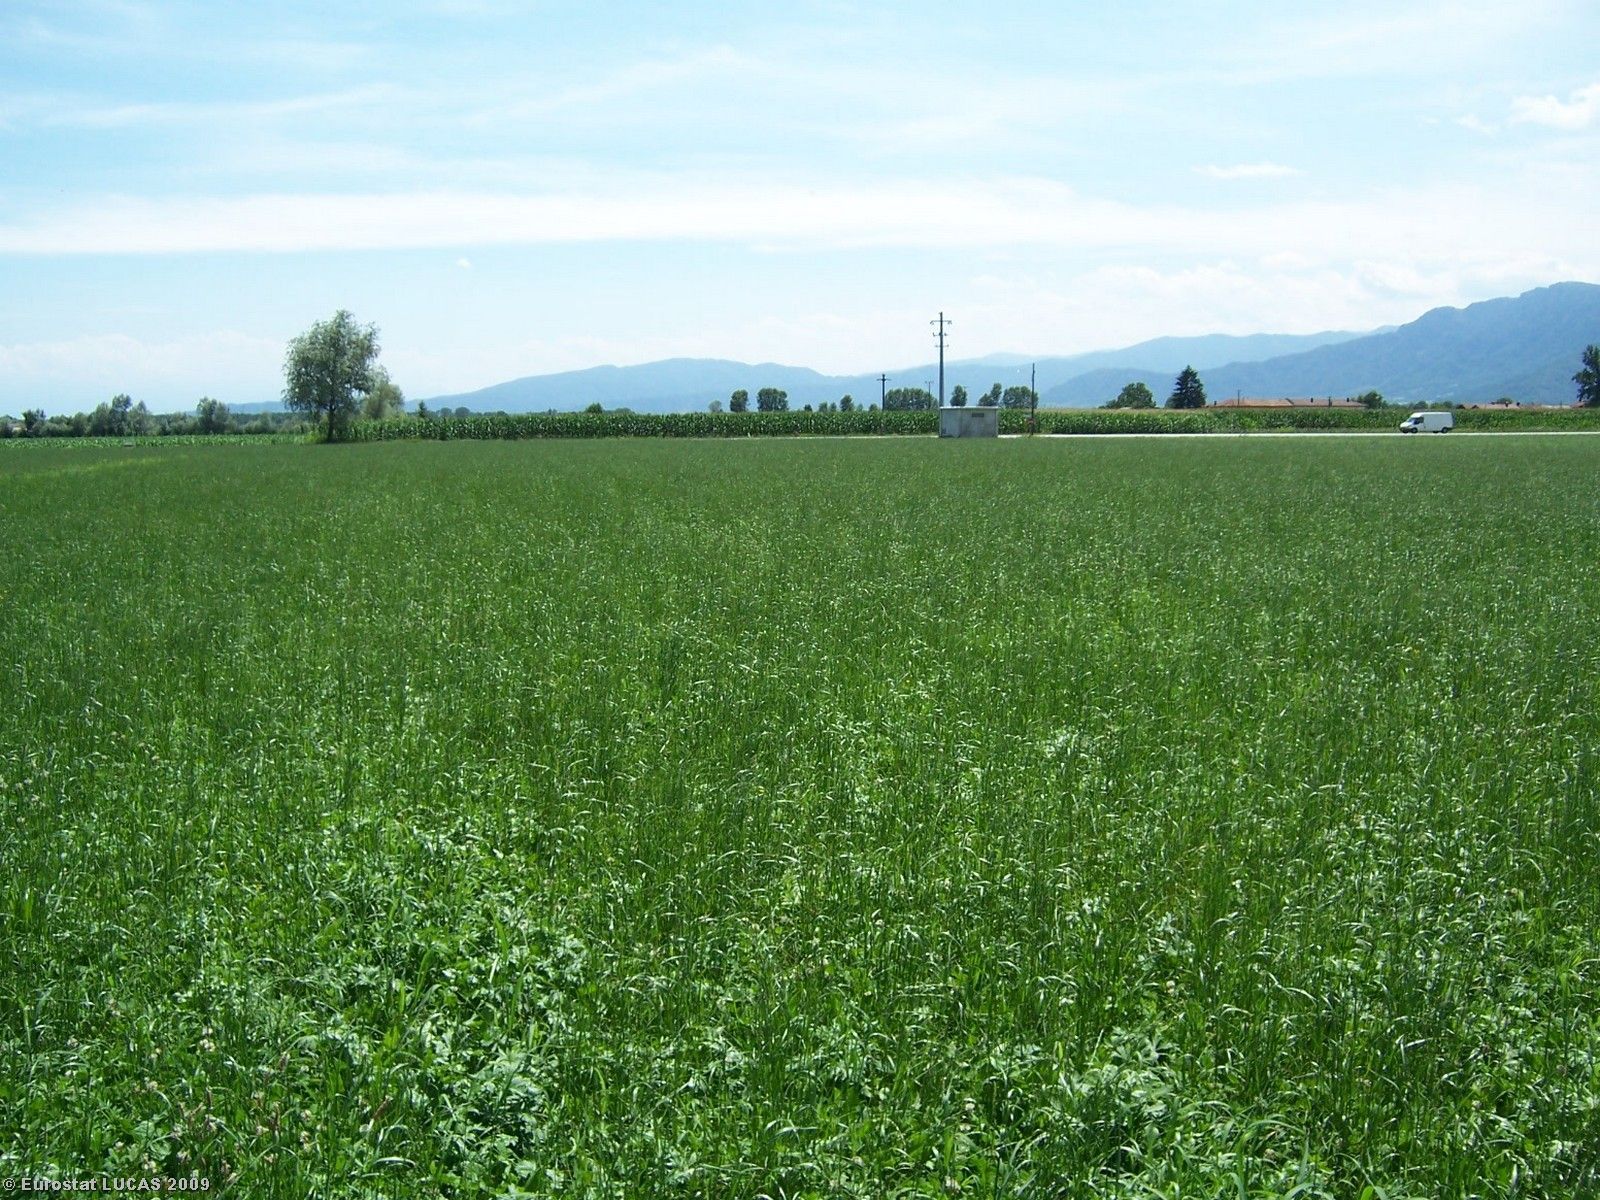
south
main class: Grassland
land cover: Grassland without tree/shrub cover
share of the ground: > 75 %
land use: Agriculture (excluding fallow land and kitchen gardens)
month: July
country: IT
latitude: 44.7874
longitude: 7.4138
